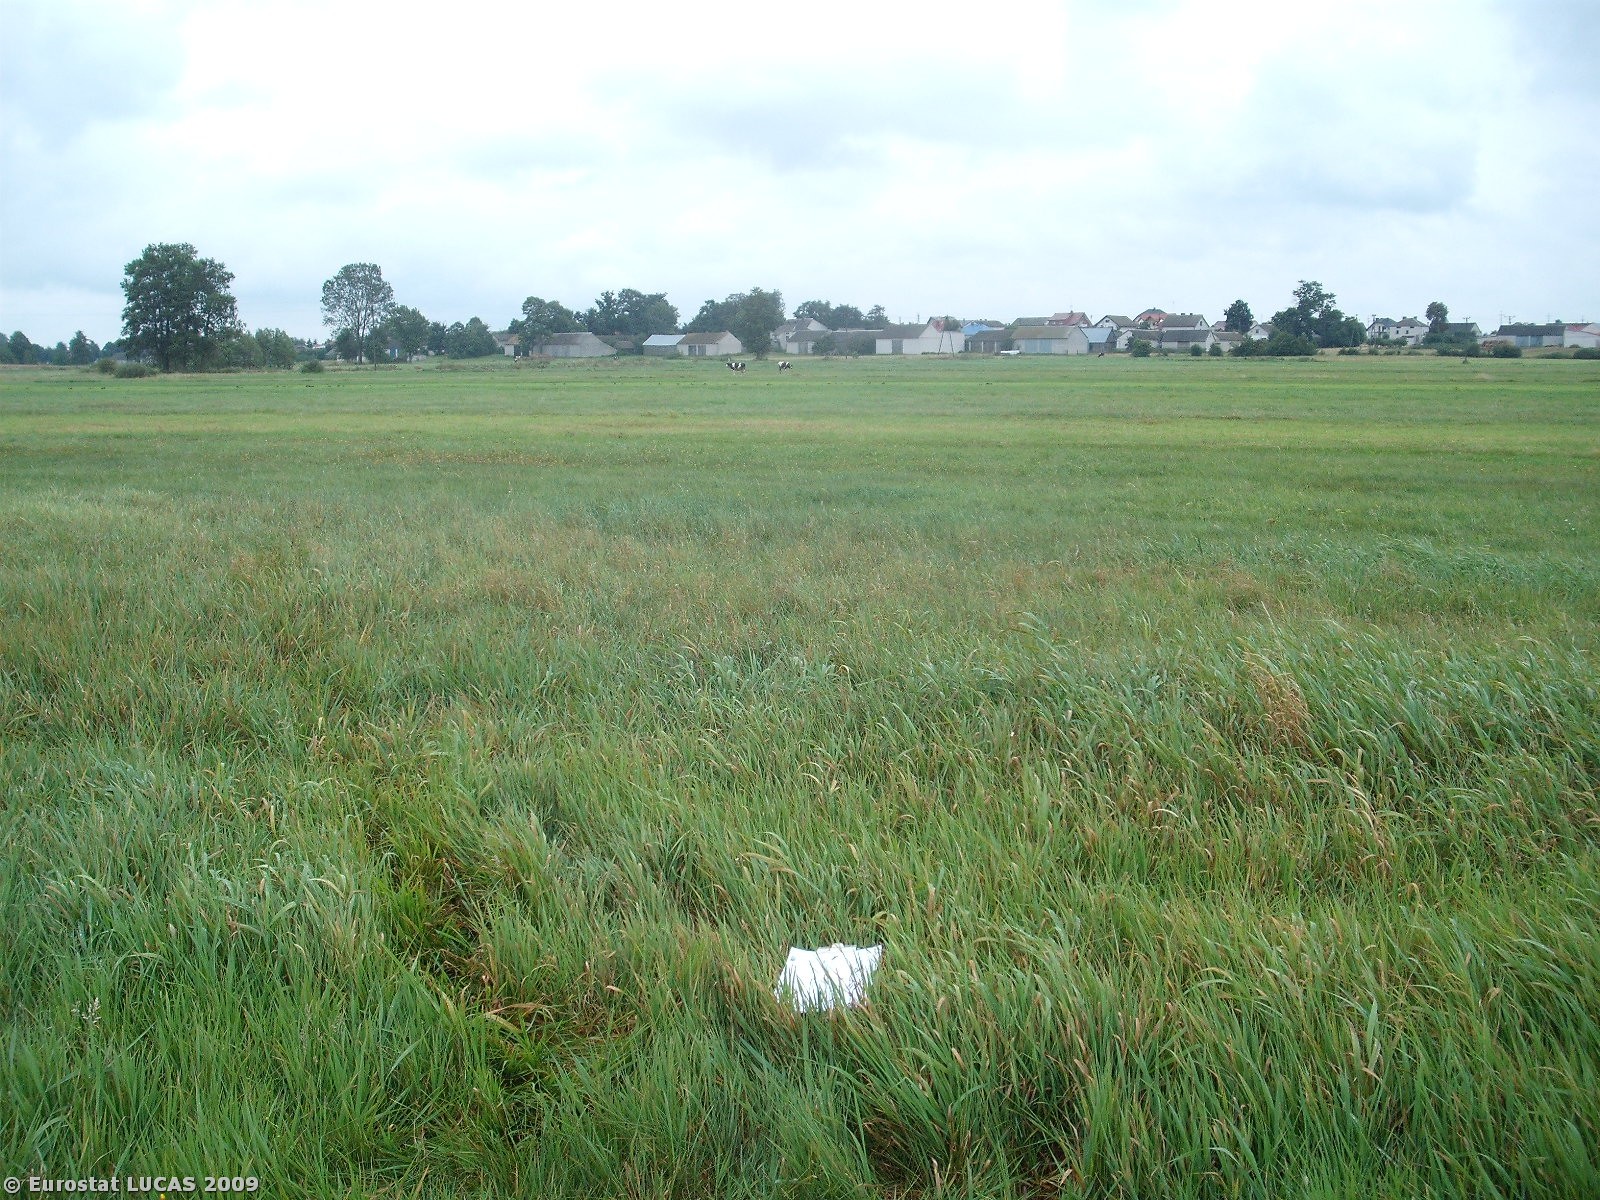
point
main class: Grassland
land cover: Grassland without tree/shrub cover
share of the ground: > 75 %
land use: Agriculture (excluding fallow land and kitchen gardens)
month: September
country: PL
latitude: 51.7529
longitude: 22.1273
